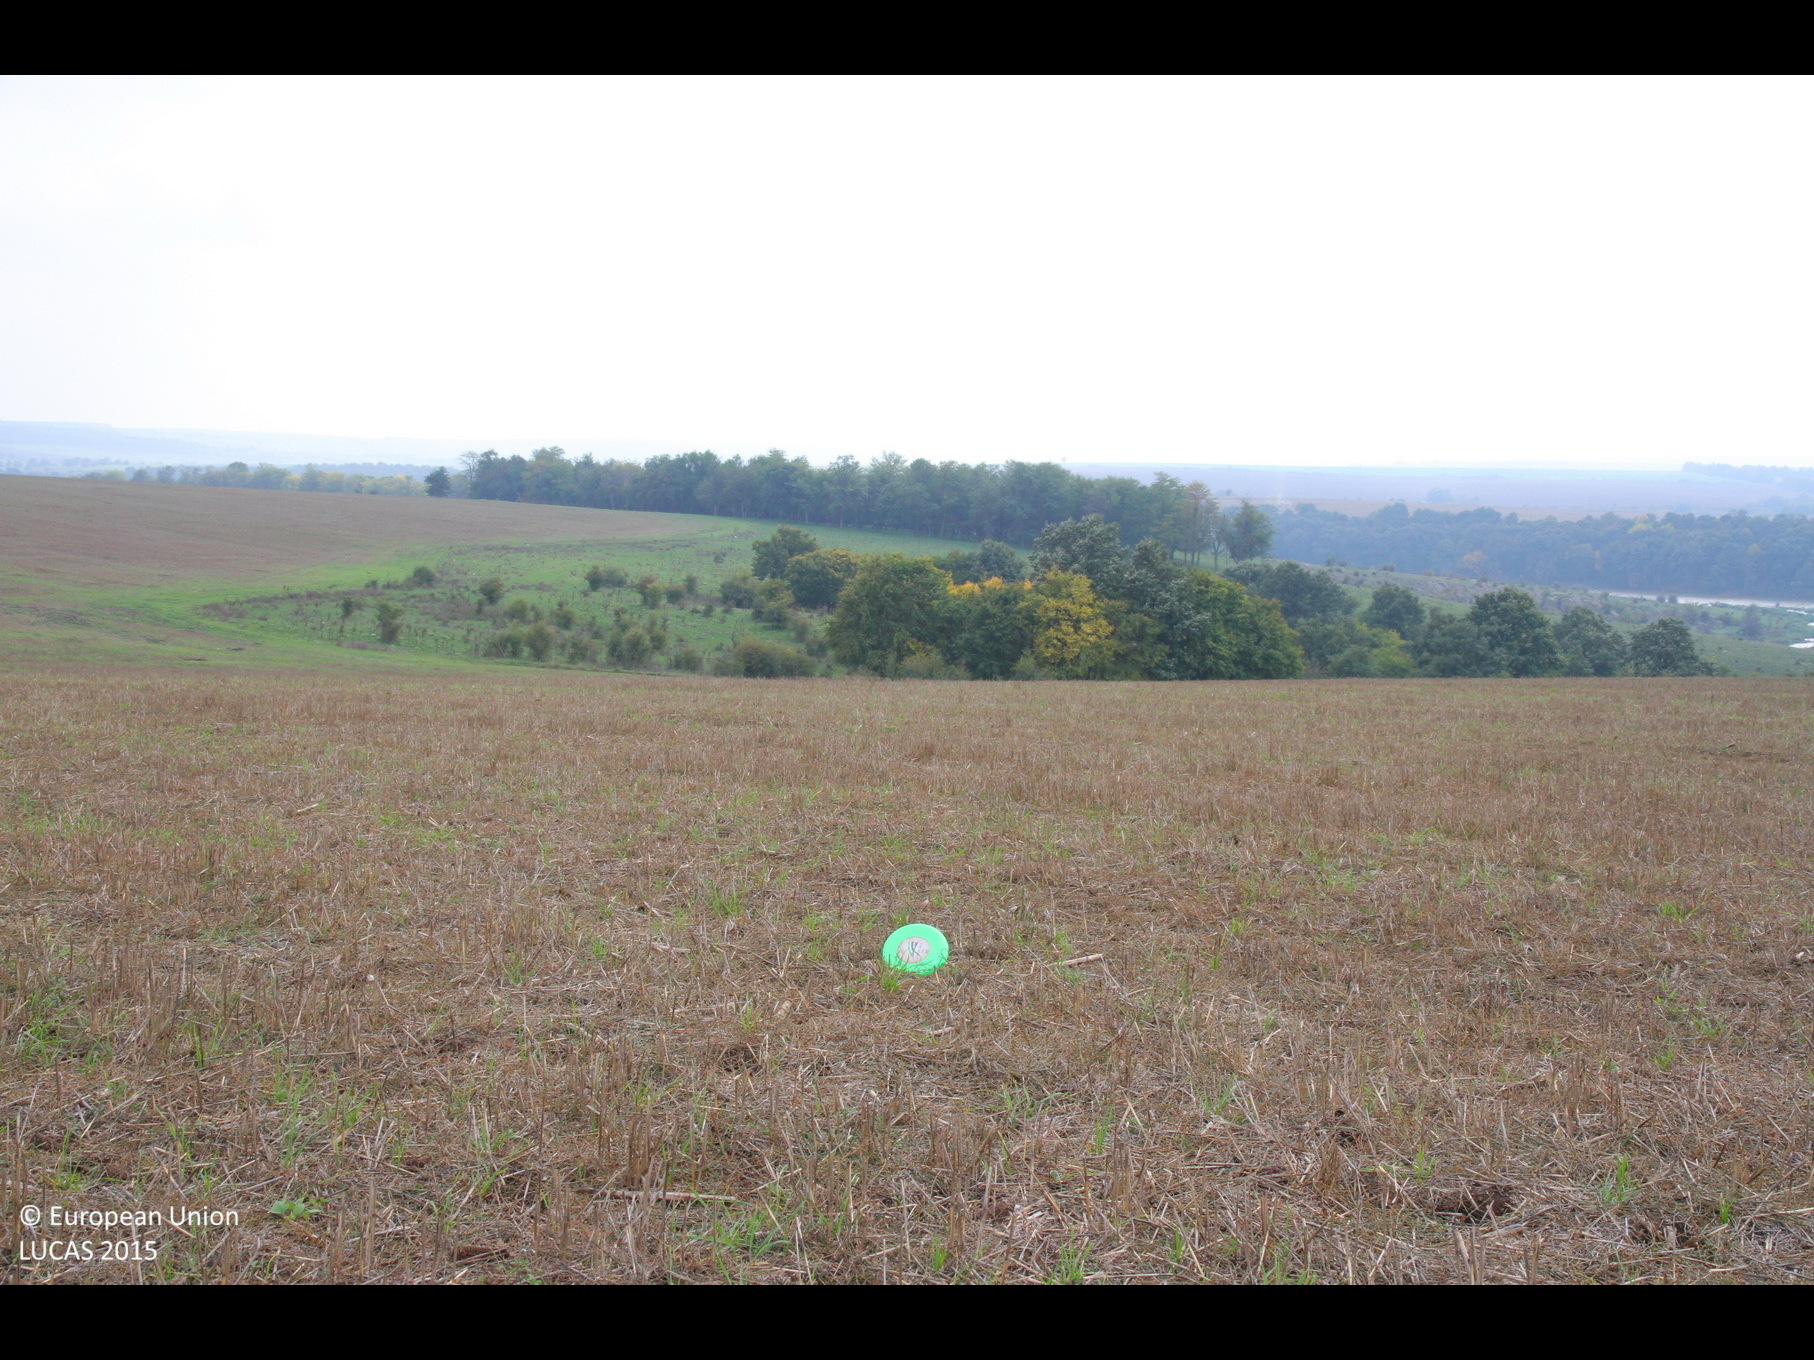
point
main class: Cropland
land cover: Common wheat
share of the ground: < 10 %
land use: Agriculture (excluding fallow land and kitchen gardens)
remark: Harvested field
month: October
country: BG
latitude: 43.5757
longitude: 27.0216
